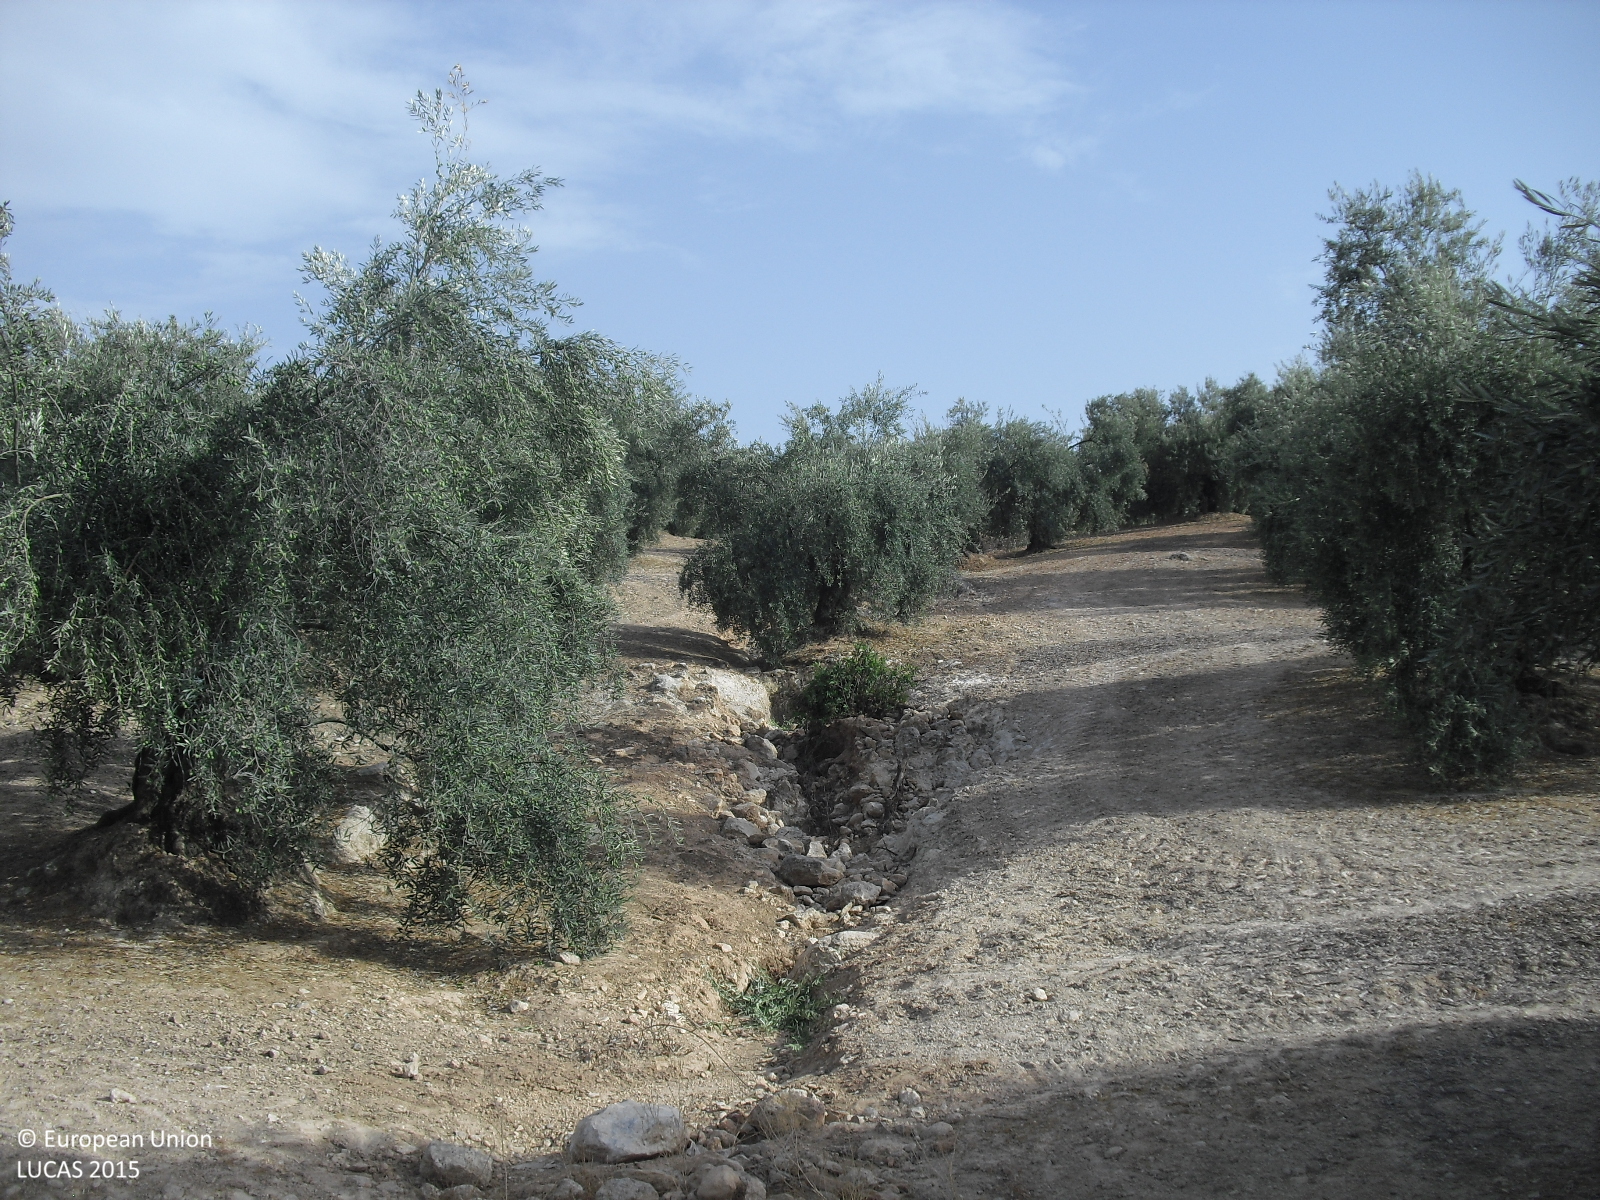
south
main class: Cropland
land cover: Olive groves
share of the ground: 25 - 50 %
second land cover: Other bare soil
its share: > 75 %
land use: Agriculture (excluding fallow land and kitchen gardens)
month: August
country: ES
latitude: 37.2637
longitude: -4.4443
